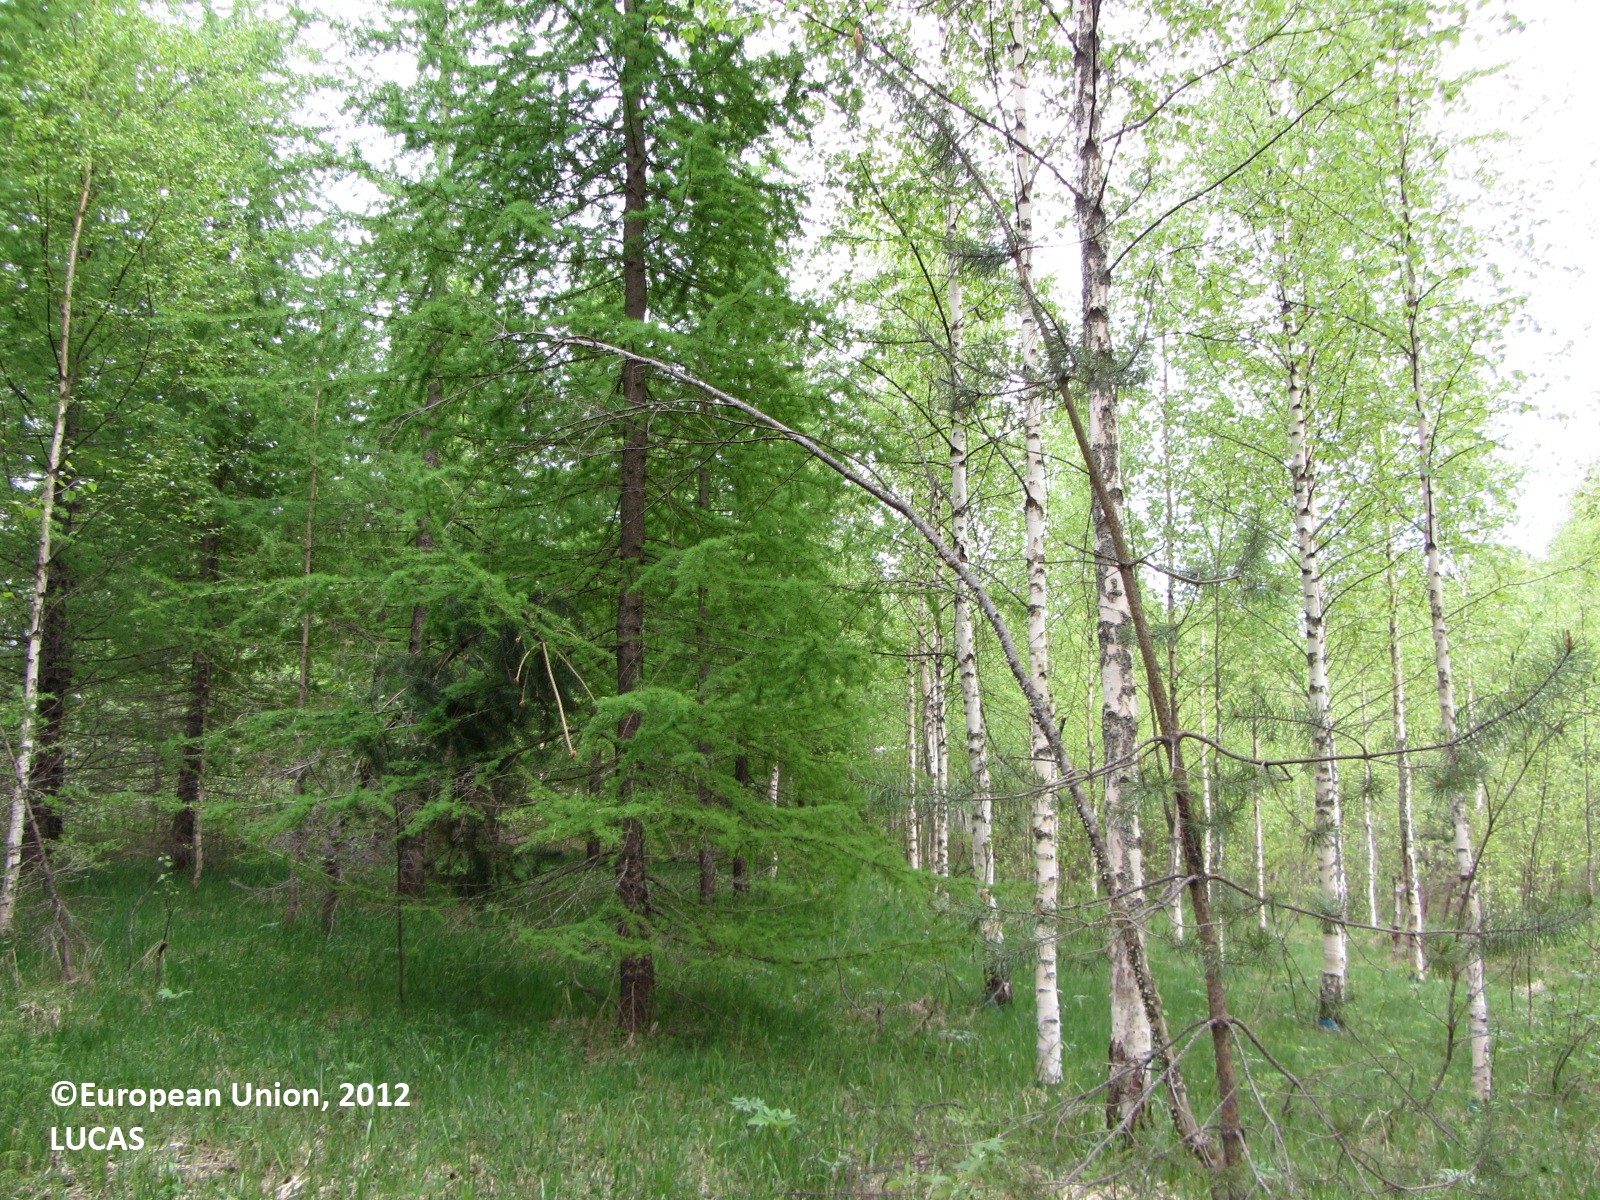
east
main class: Woodland
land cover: Broadleaved woodland
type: boreal forest
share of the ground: > 75 %
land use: Forestry
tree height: > 5 m
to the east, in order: Broadleaved woodland; Spruce dominated coniferous woodland; Shrubland with sparse tree cover; Spruce dominated coniferous woodland; Broadleaved woodland; Other bare soil; Paved roads, cycling and walking lanes; Ditches and canals; Other bare soil; Other fruit trees and berries; Tracks; Artificial constructions in urban areas; Grassland with sparse tree/shrub cover; Ditches and canals; Spruce dominated mixed woodland; Lines of trees; Grassland without tree/shrub cover; Spruce dominated mixed woodland
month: May
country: FI
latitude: 62.4014
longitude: 25.4156
